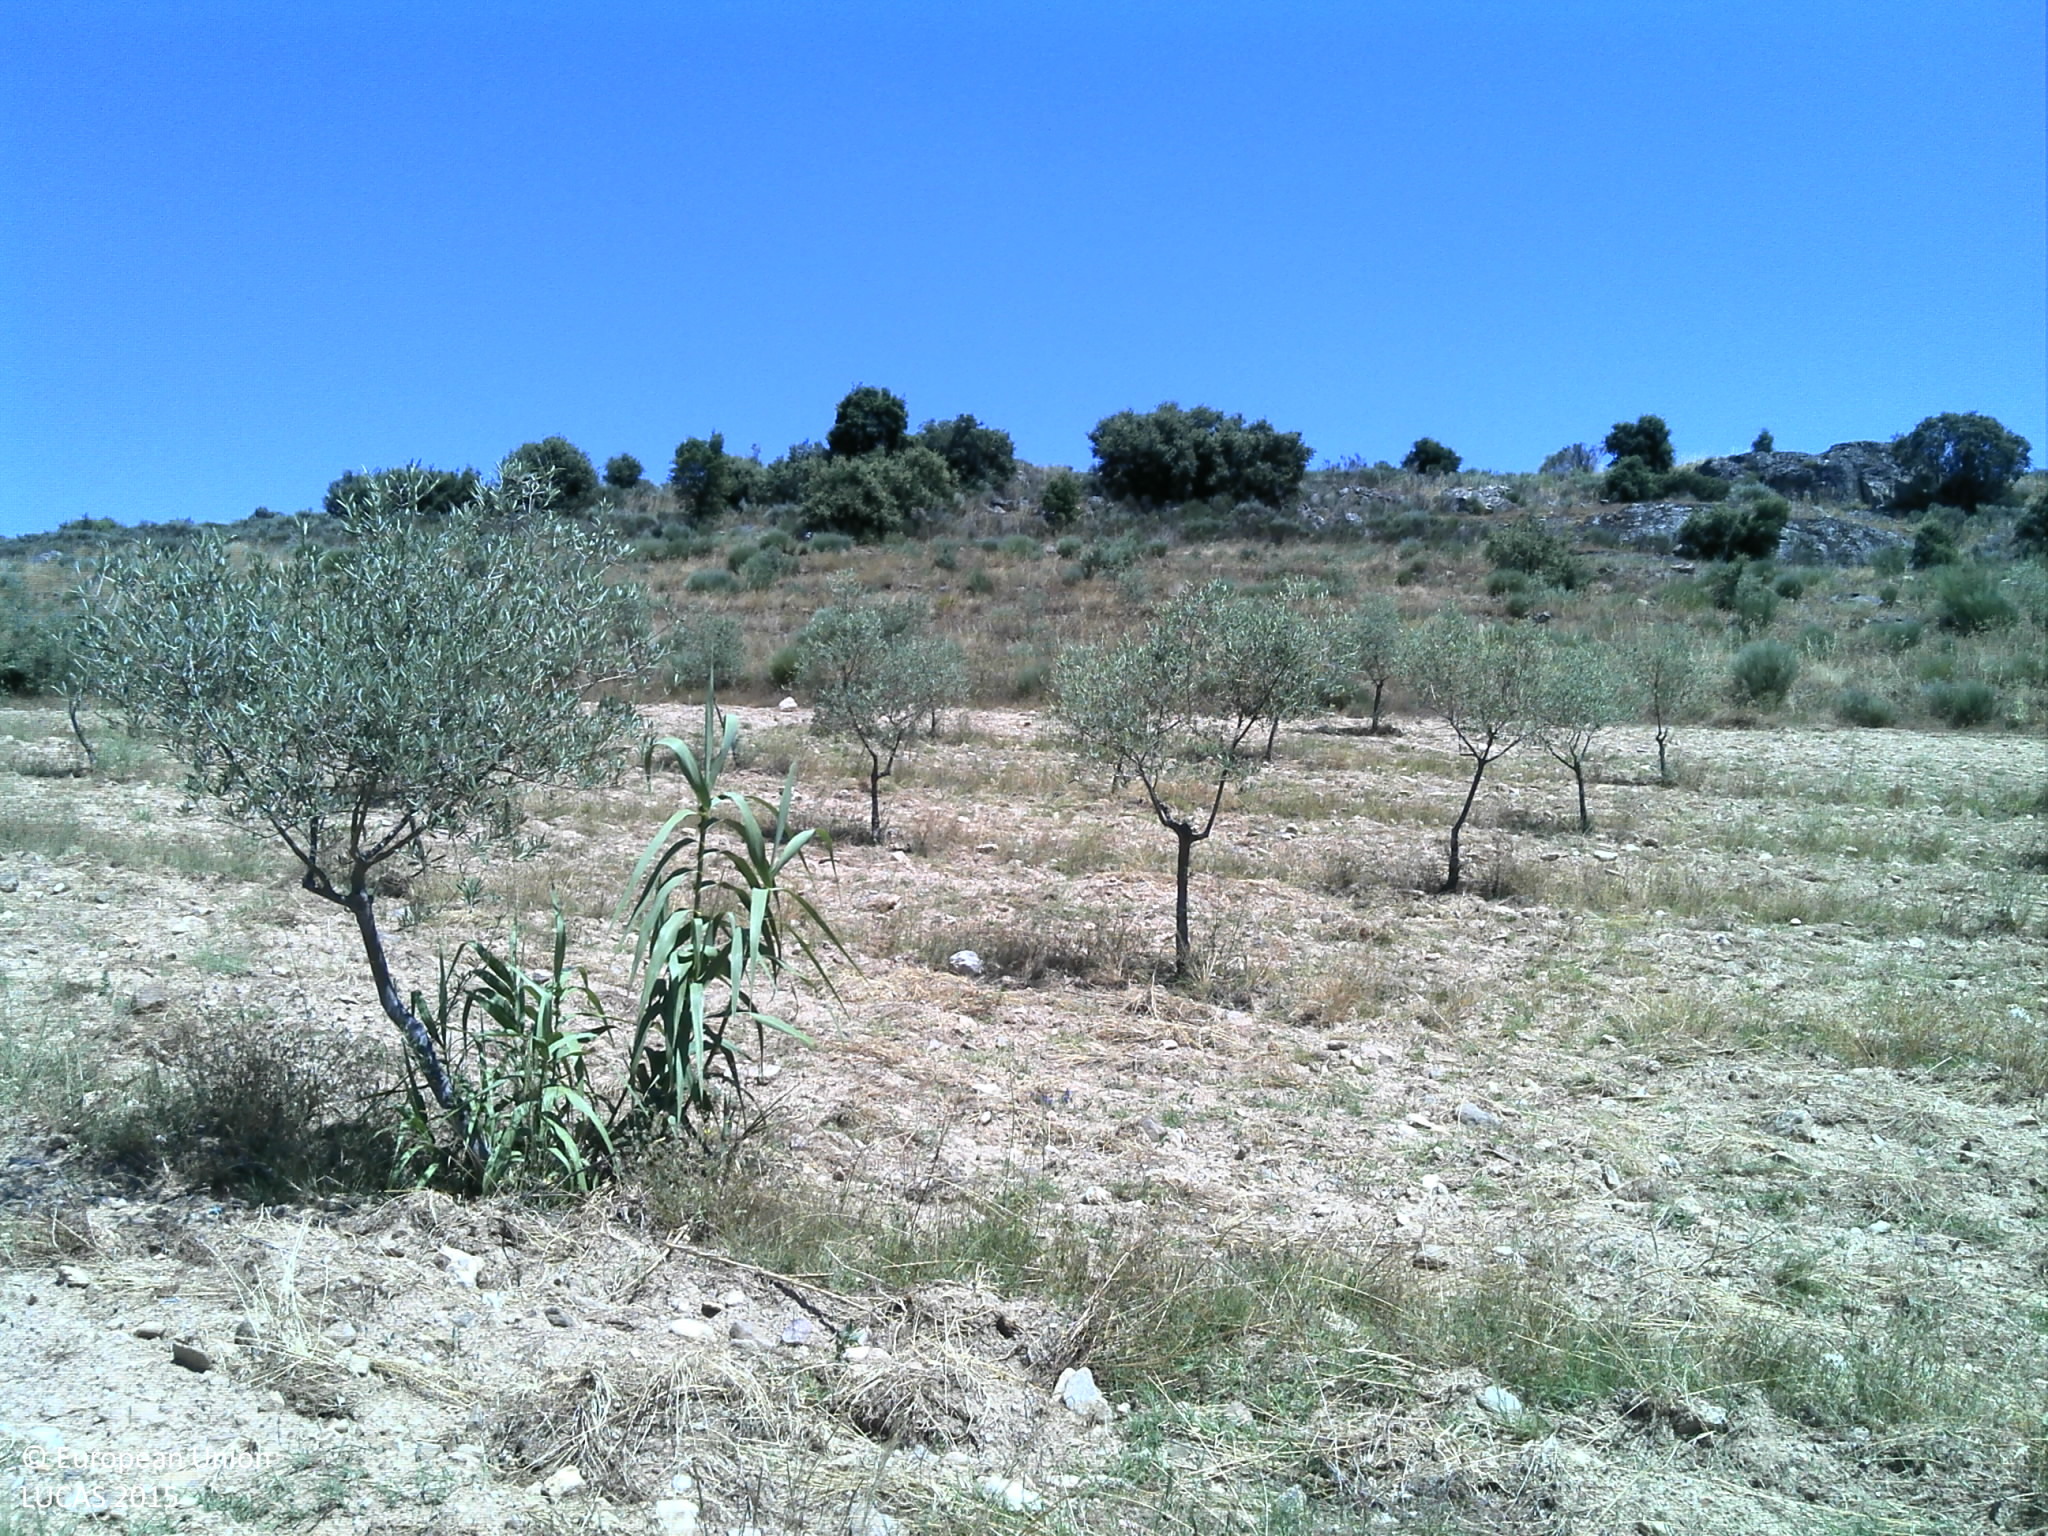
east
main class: Cropland
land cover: Olive groves
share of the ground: 10 - 25 %
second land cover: Grassland without tree/shrub cover
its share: 10 - 25 %
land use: Agriculture (excluding fallow land and kitchen gardens)
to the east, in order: Olive groves; Grassland without tree/shrub cover; Olive groves; Broadleaved woodland; Shrubland with sparse tree cover; Olive groves; Ditches and canals; Olive groves
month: June
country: PT
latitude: 40.9177
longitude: -7.2697
